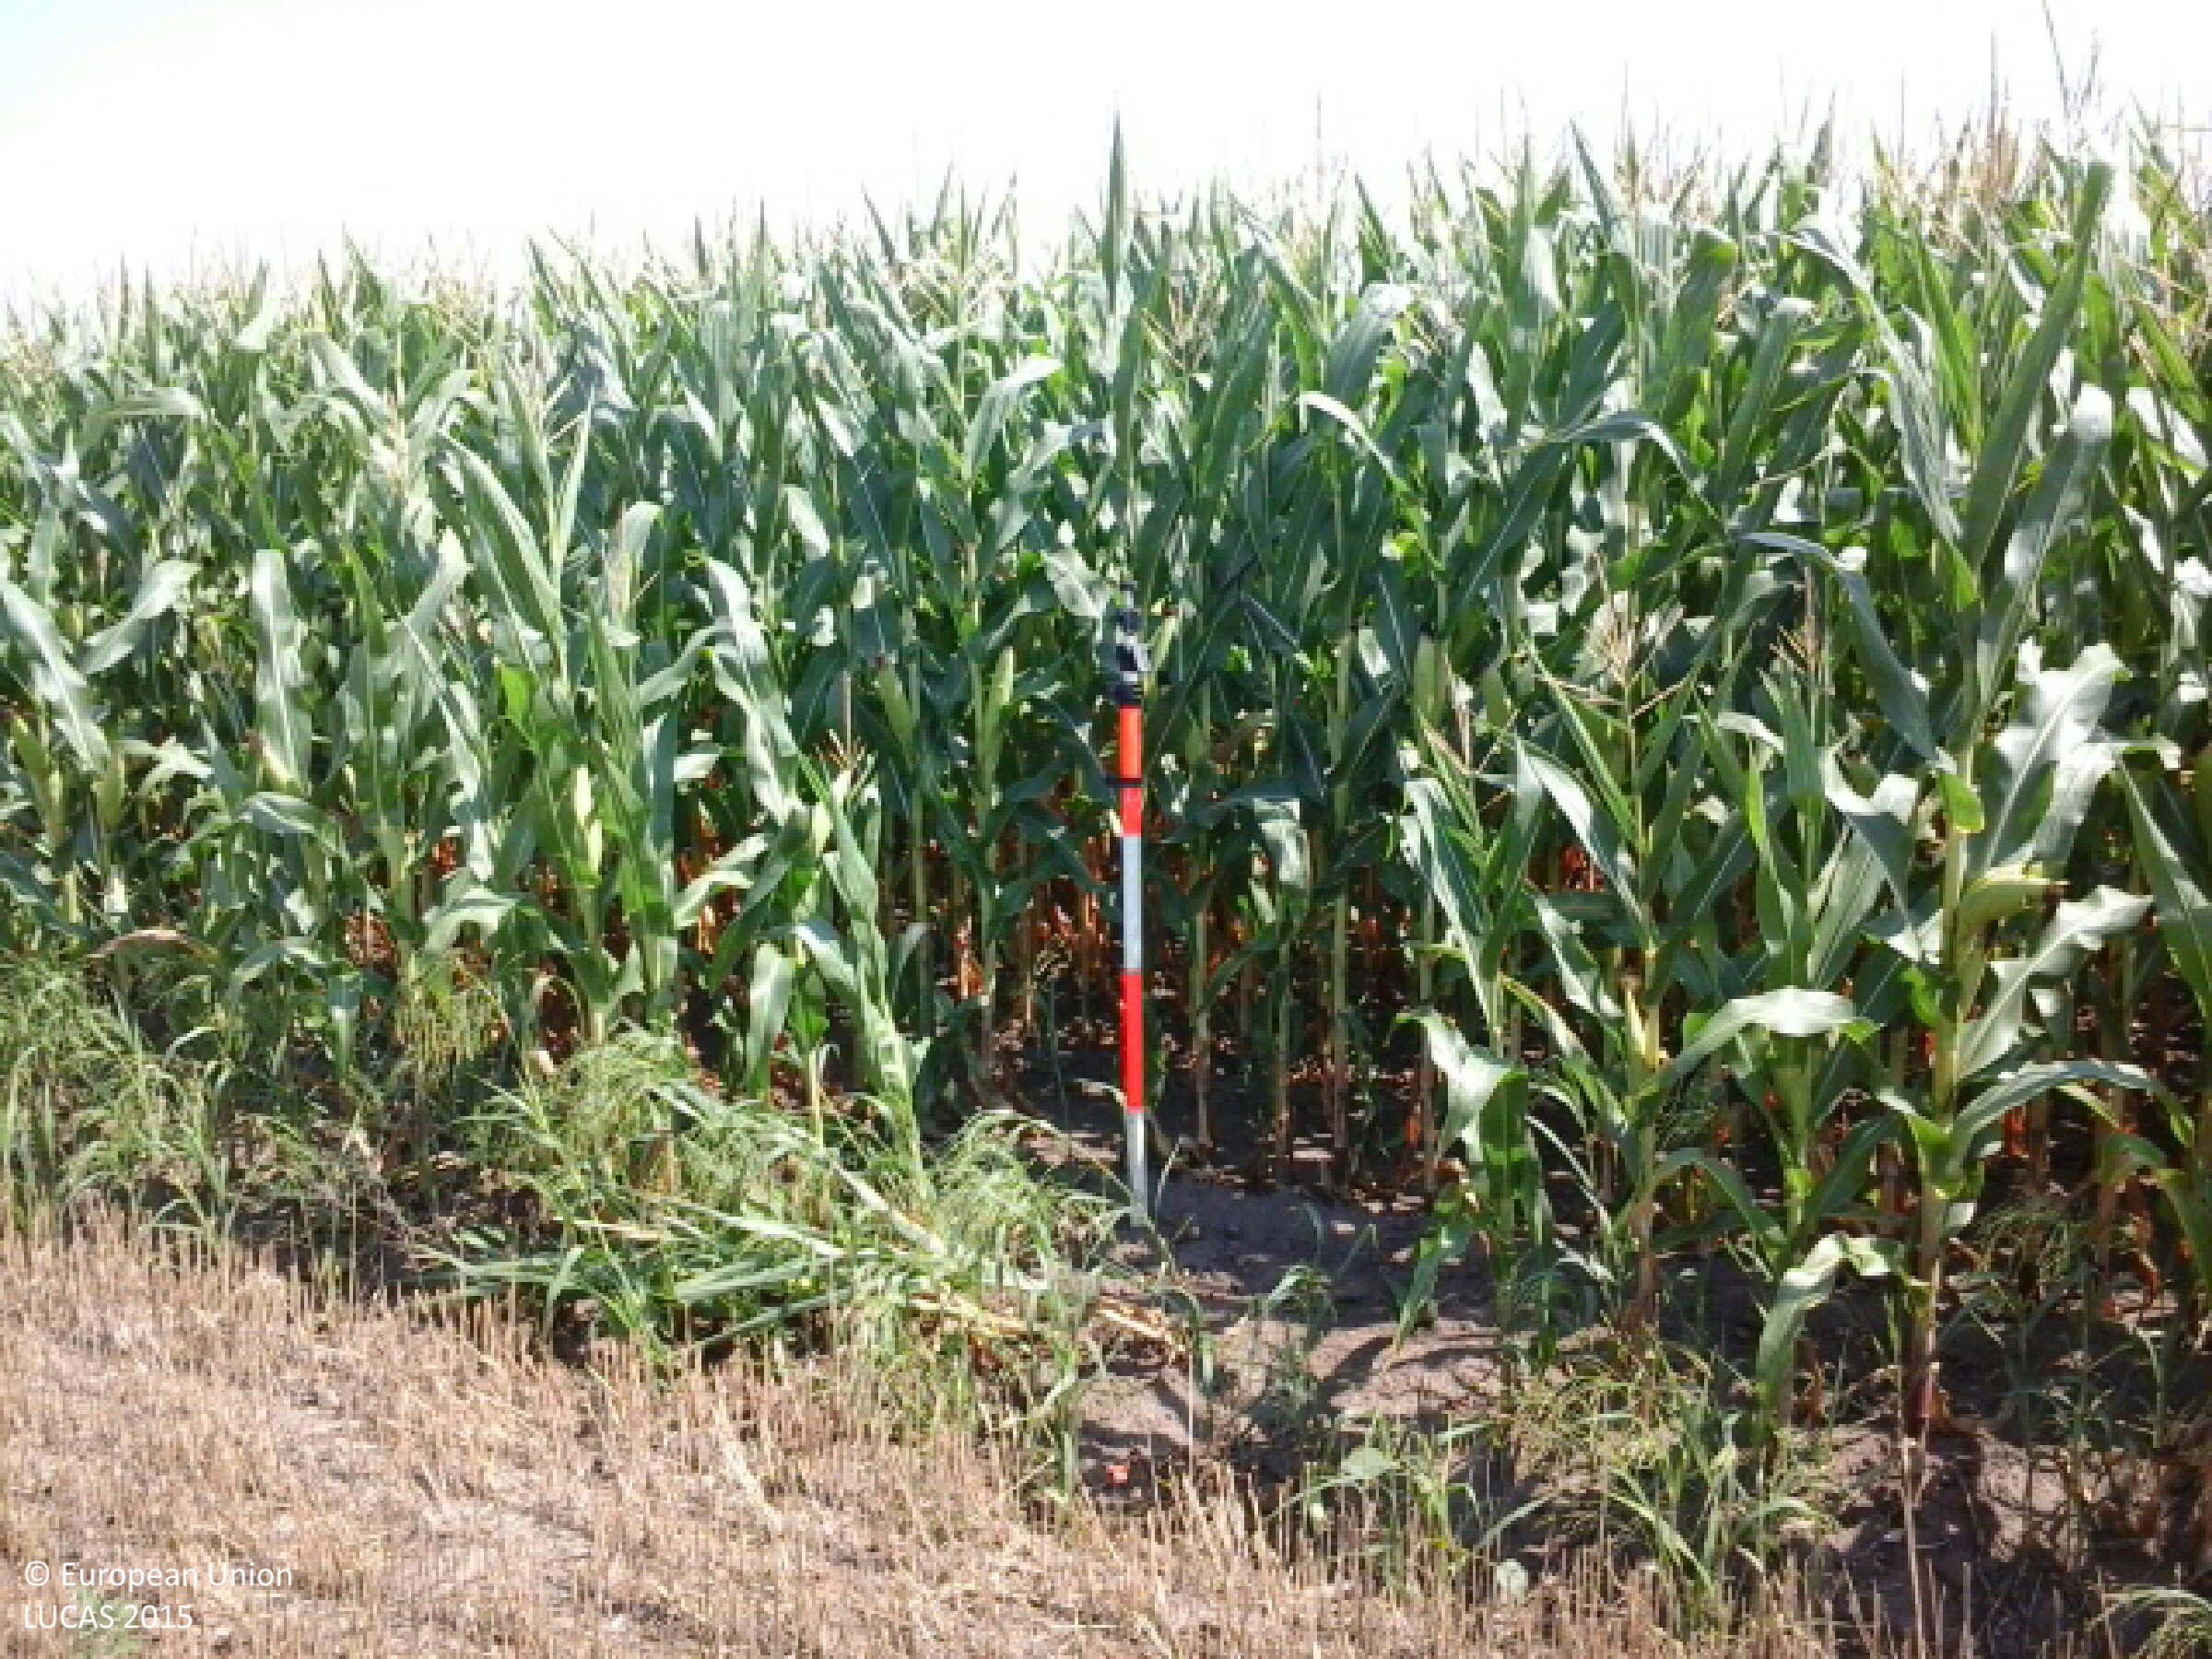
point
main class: Cropland
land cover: Maize
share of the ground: > 75 %
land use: Agriculture (excluding fallow land and kitchen gardens)
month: August
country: HU
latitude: 47.5948
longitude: 18.1644
